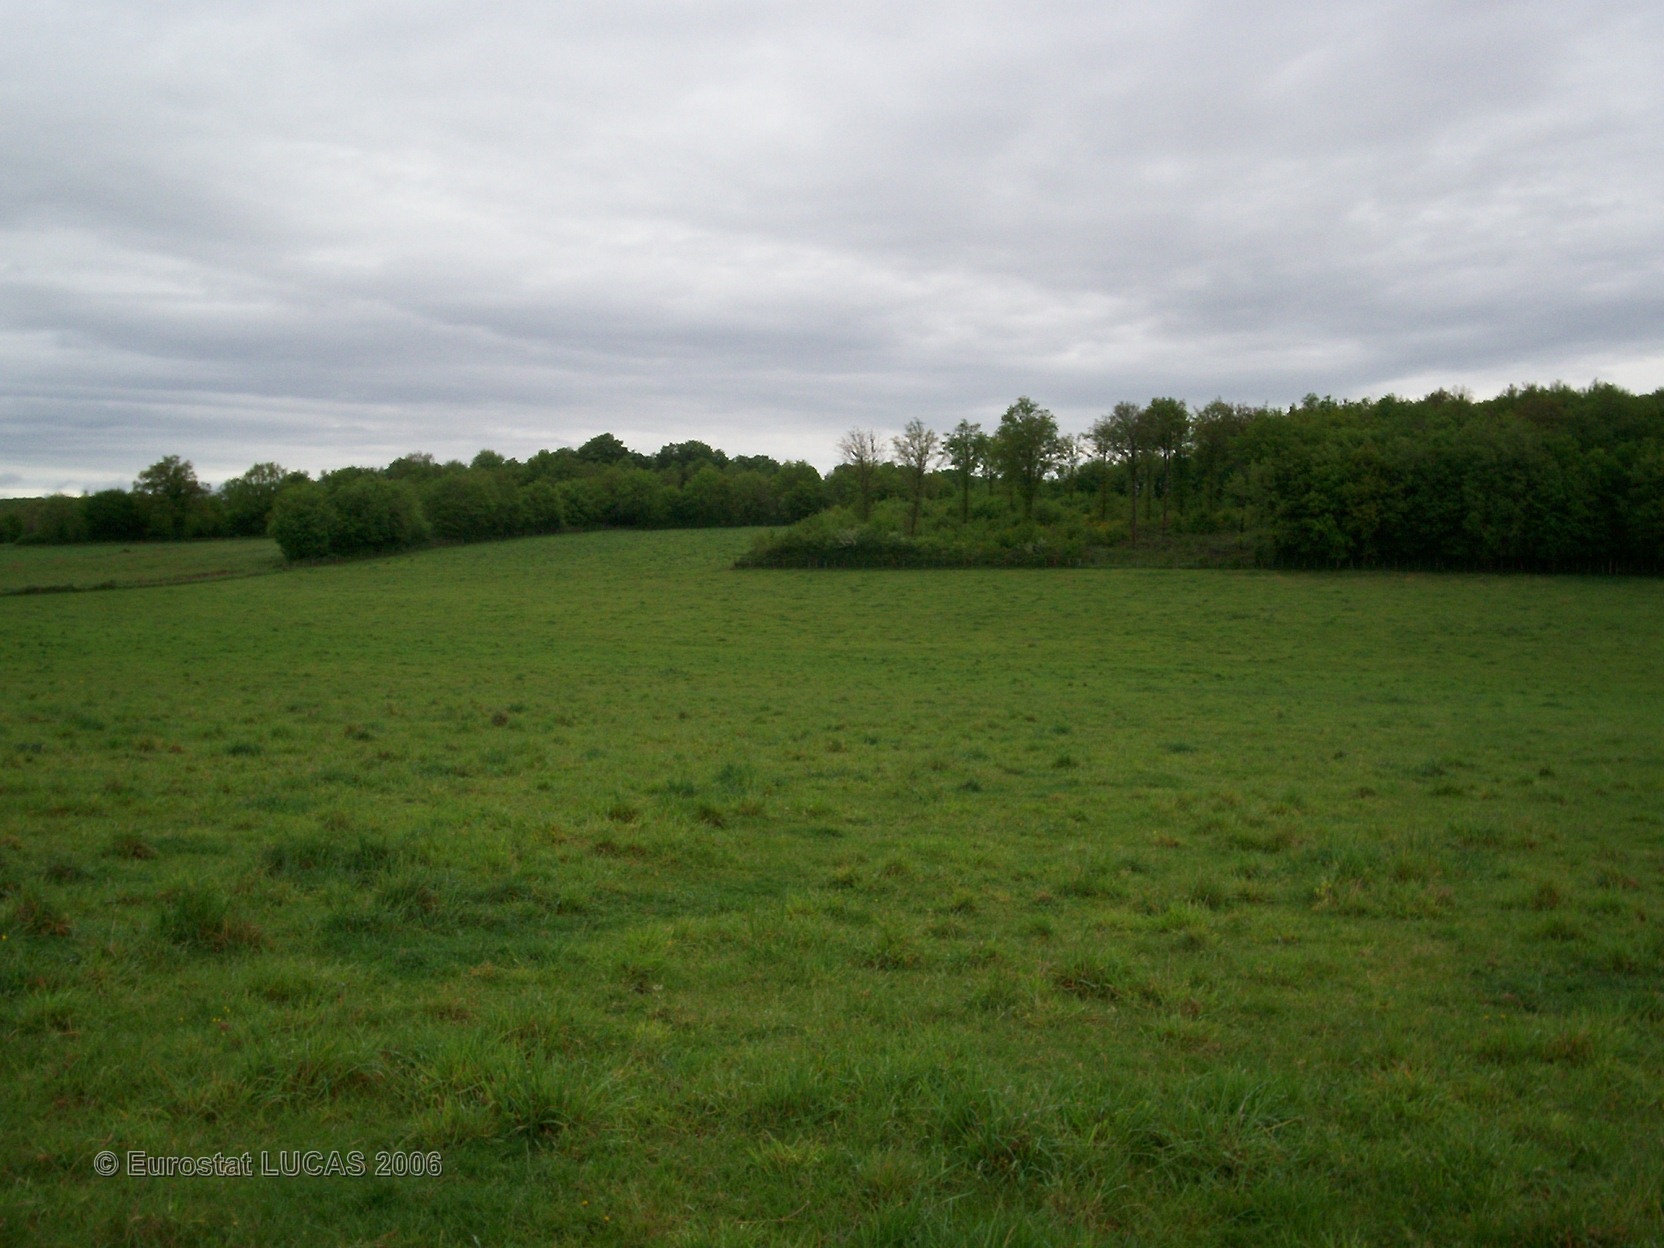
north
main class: Grassland
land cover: Grassland without tree/shrub cover
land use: Agriculture (excluding fallow land and kitchen gardens)
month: May
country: FR
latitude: 46.0485
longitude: 0.4334
